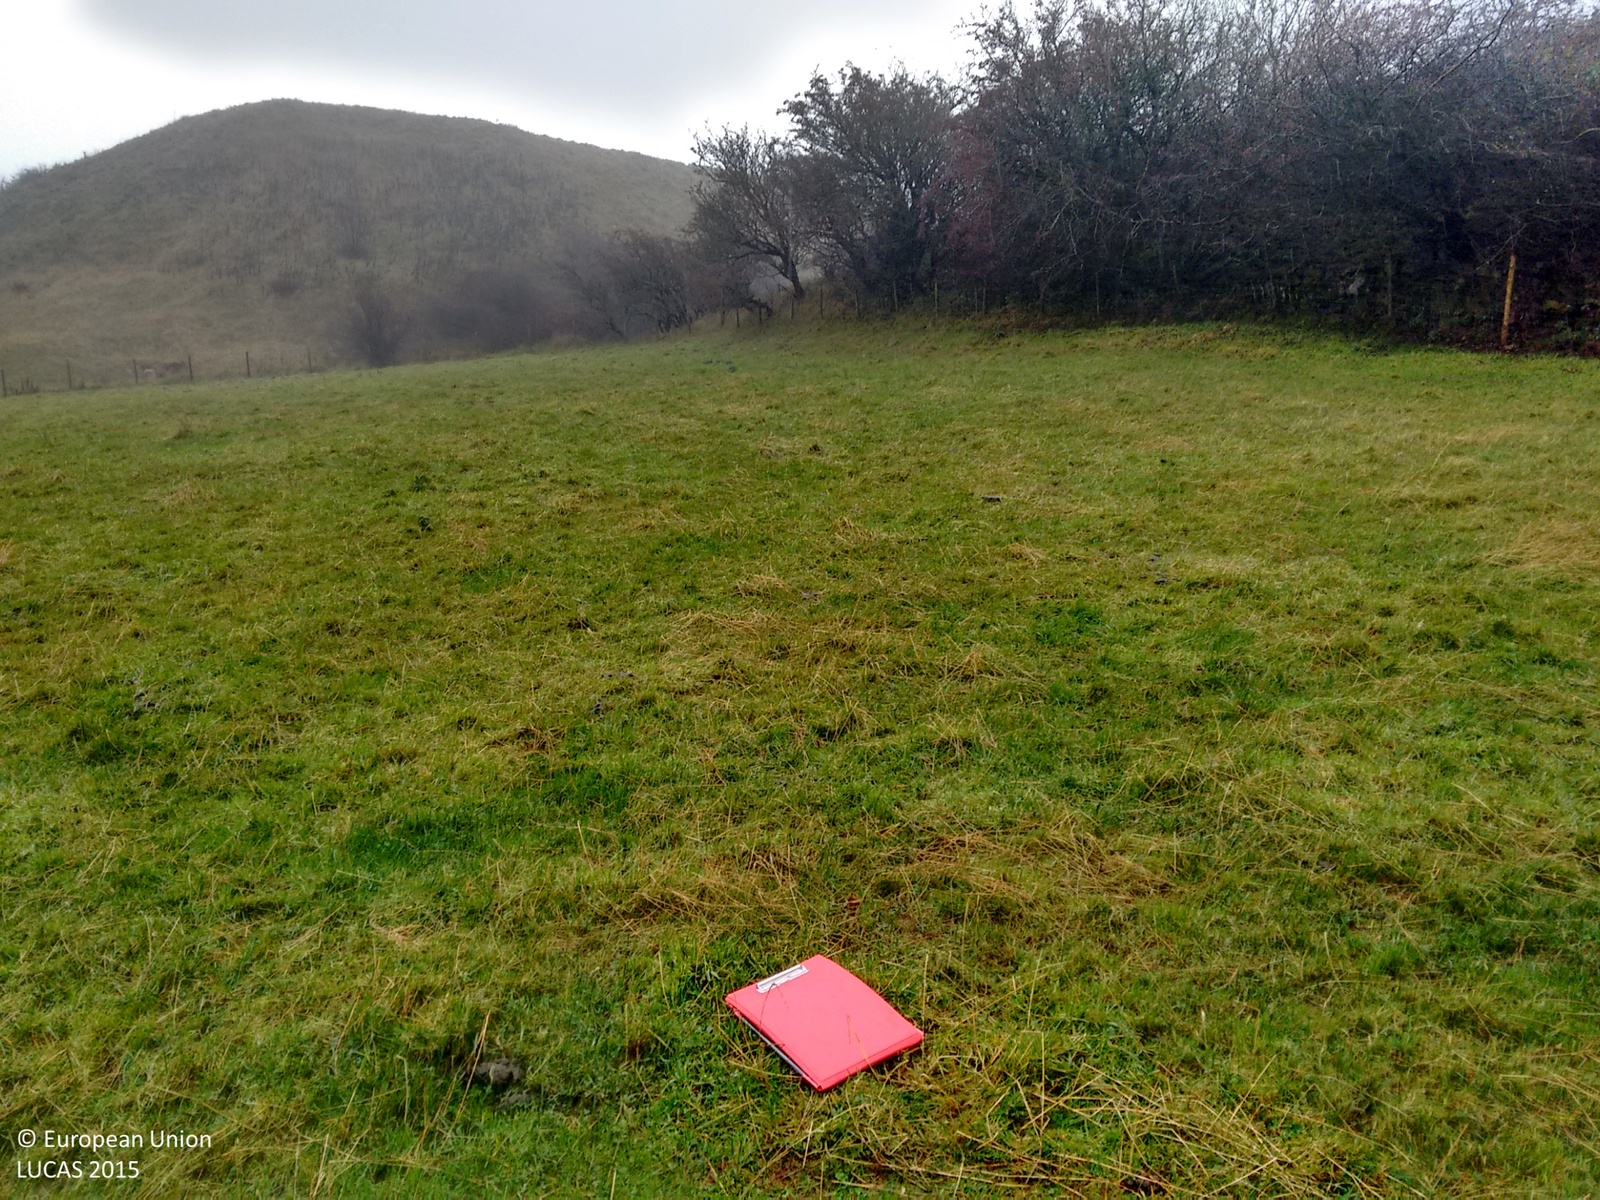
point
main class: Grassland
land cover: Grassland without tree/shrub cover
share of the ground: > 75 %
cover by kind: herbaceous plants 100 %
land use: Agriculture (excluding fallow land and kitchen gardens)
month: November
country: GB
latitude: 54.5442
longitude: -3.4521
